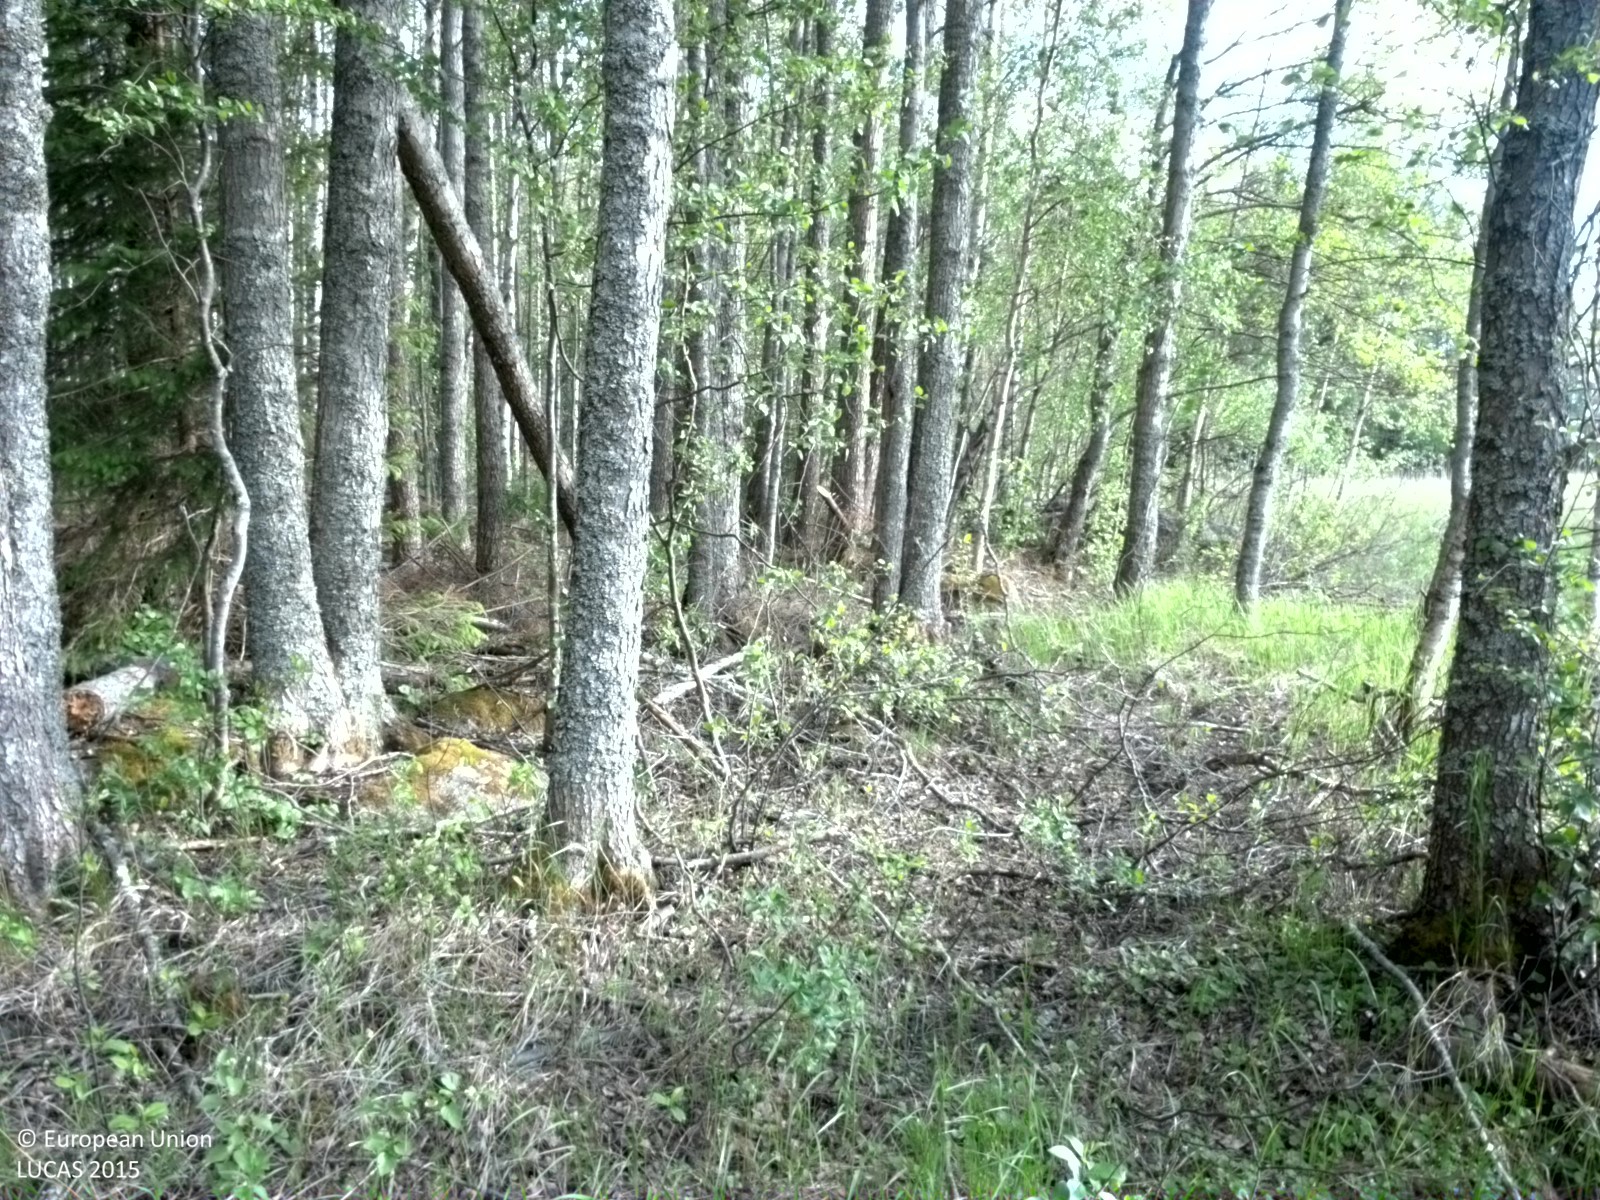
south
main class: Woodland
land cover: Broadleaved woodland
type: non-riverine alder, birch or aspen forest
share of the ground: 25 - 50 %
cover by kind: broadleaved forest trees 45 %, herbaceous plants 30 %, shrubs 15 %, coniferous forest trees 5 %, lichens and mosses 5 %
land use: Forestry
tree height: > 5 m
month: June
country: SE
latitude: 60.3036
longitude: 17.2113
